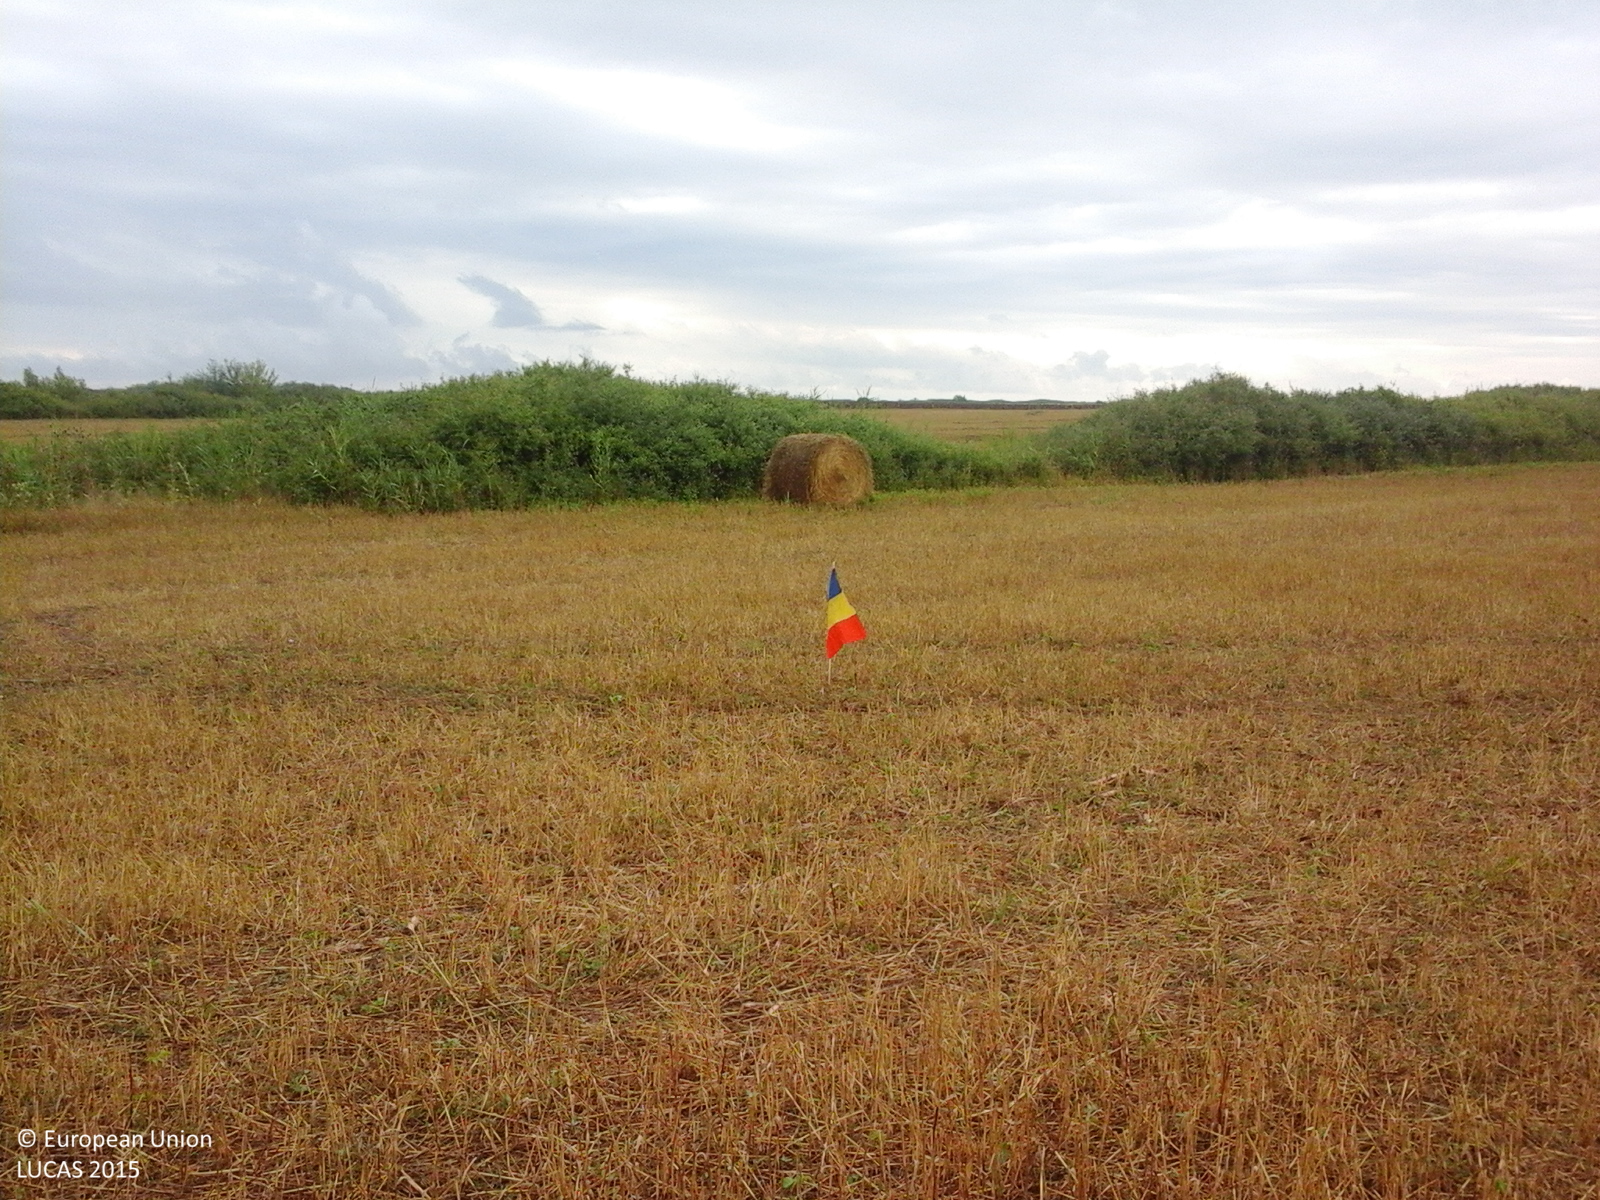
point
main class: Cropland
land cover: Common wheat
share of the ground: 50 - 75 %
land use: Agriculture (excluding fallow land and kitchen gardens)
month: August
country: RO
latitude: 45.5731
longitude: 21.0866
